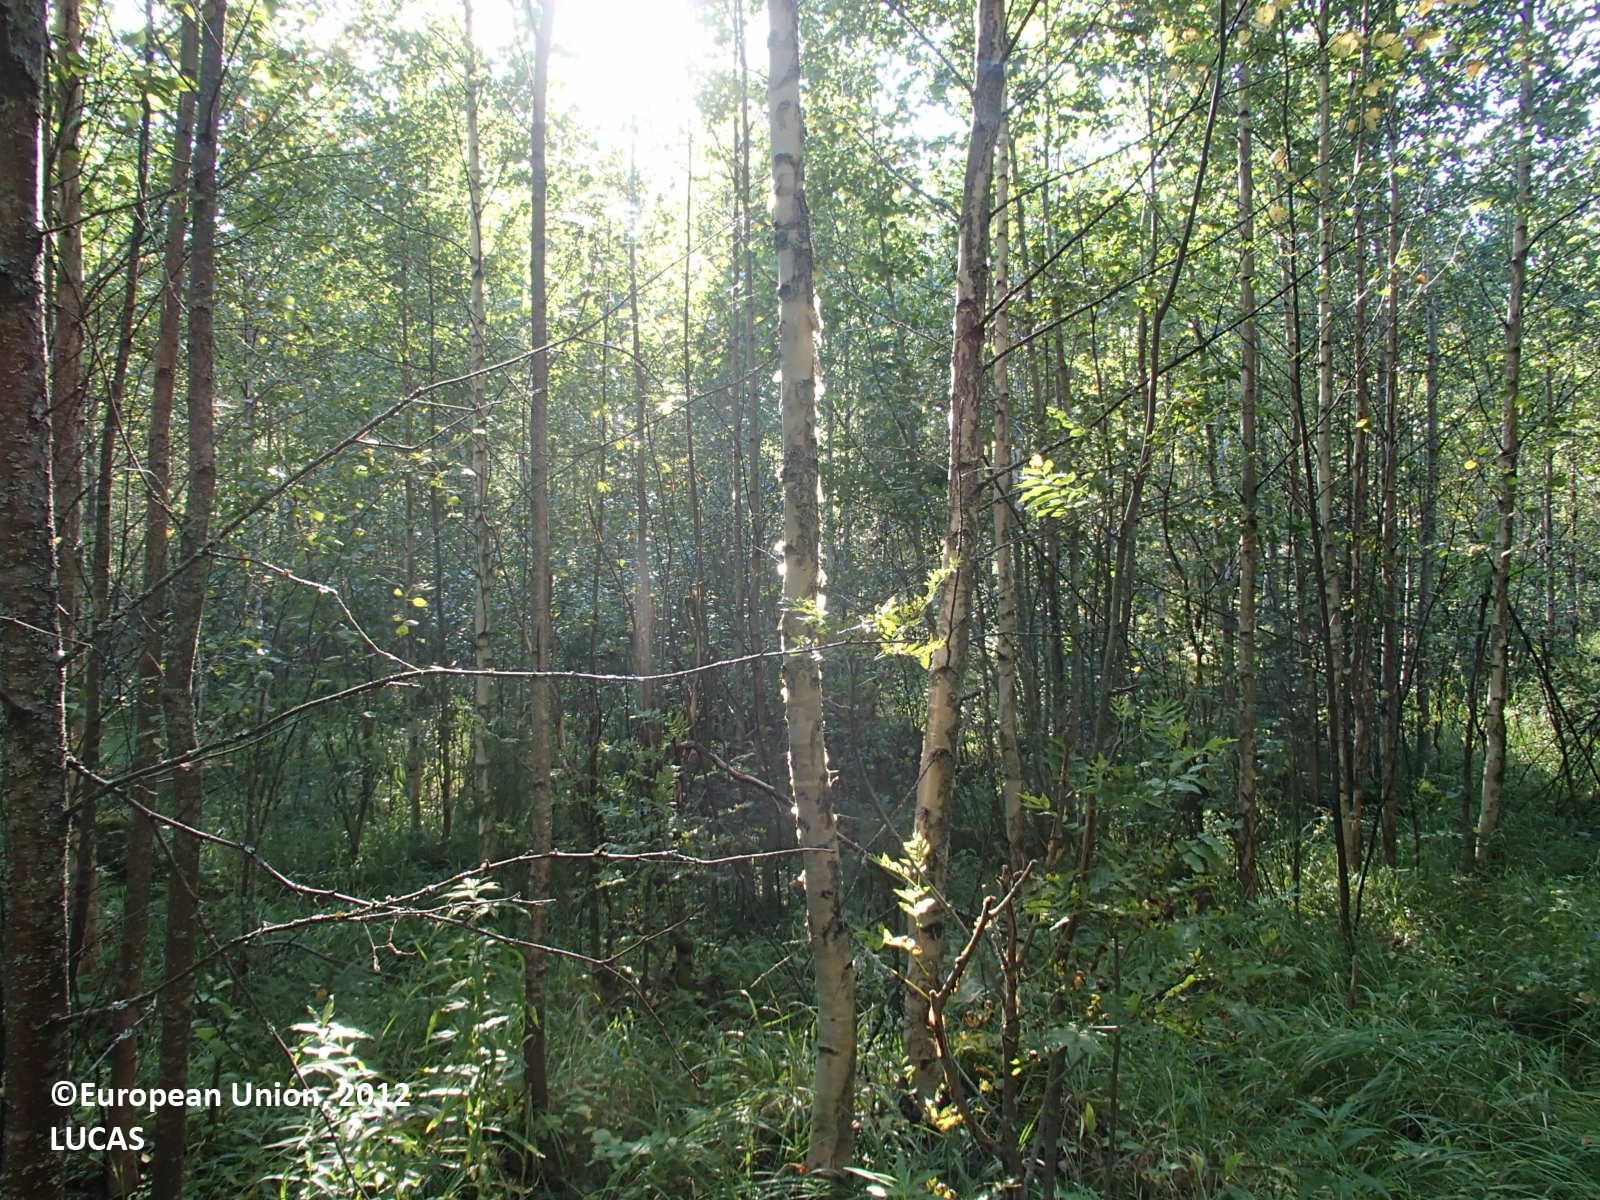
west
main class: Woodland
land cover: Broadleaved woodland
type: non-riverine alder, birch or aspen forest
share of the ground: > 75 %
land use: Forestry
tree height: > 5 m
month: August
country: FI
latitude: 63.5264
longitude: 27.9647
